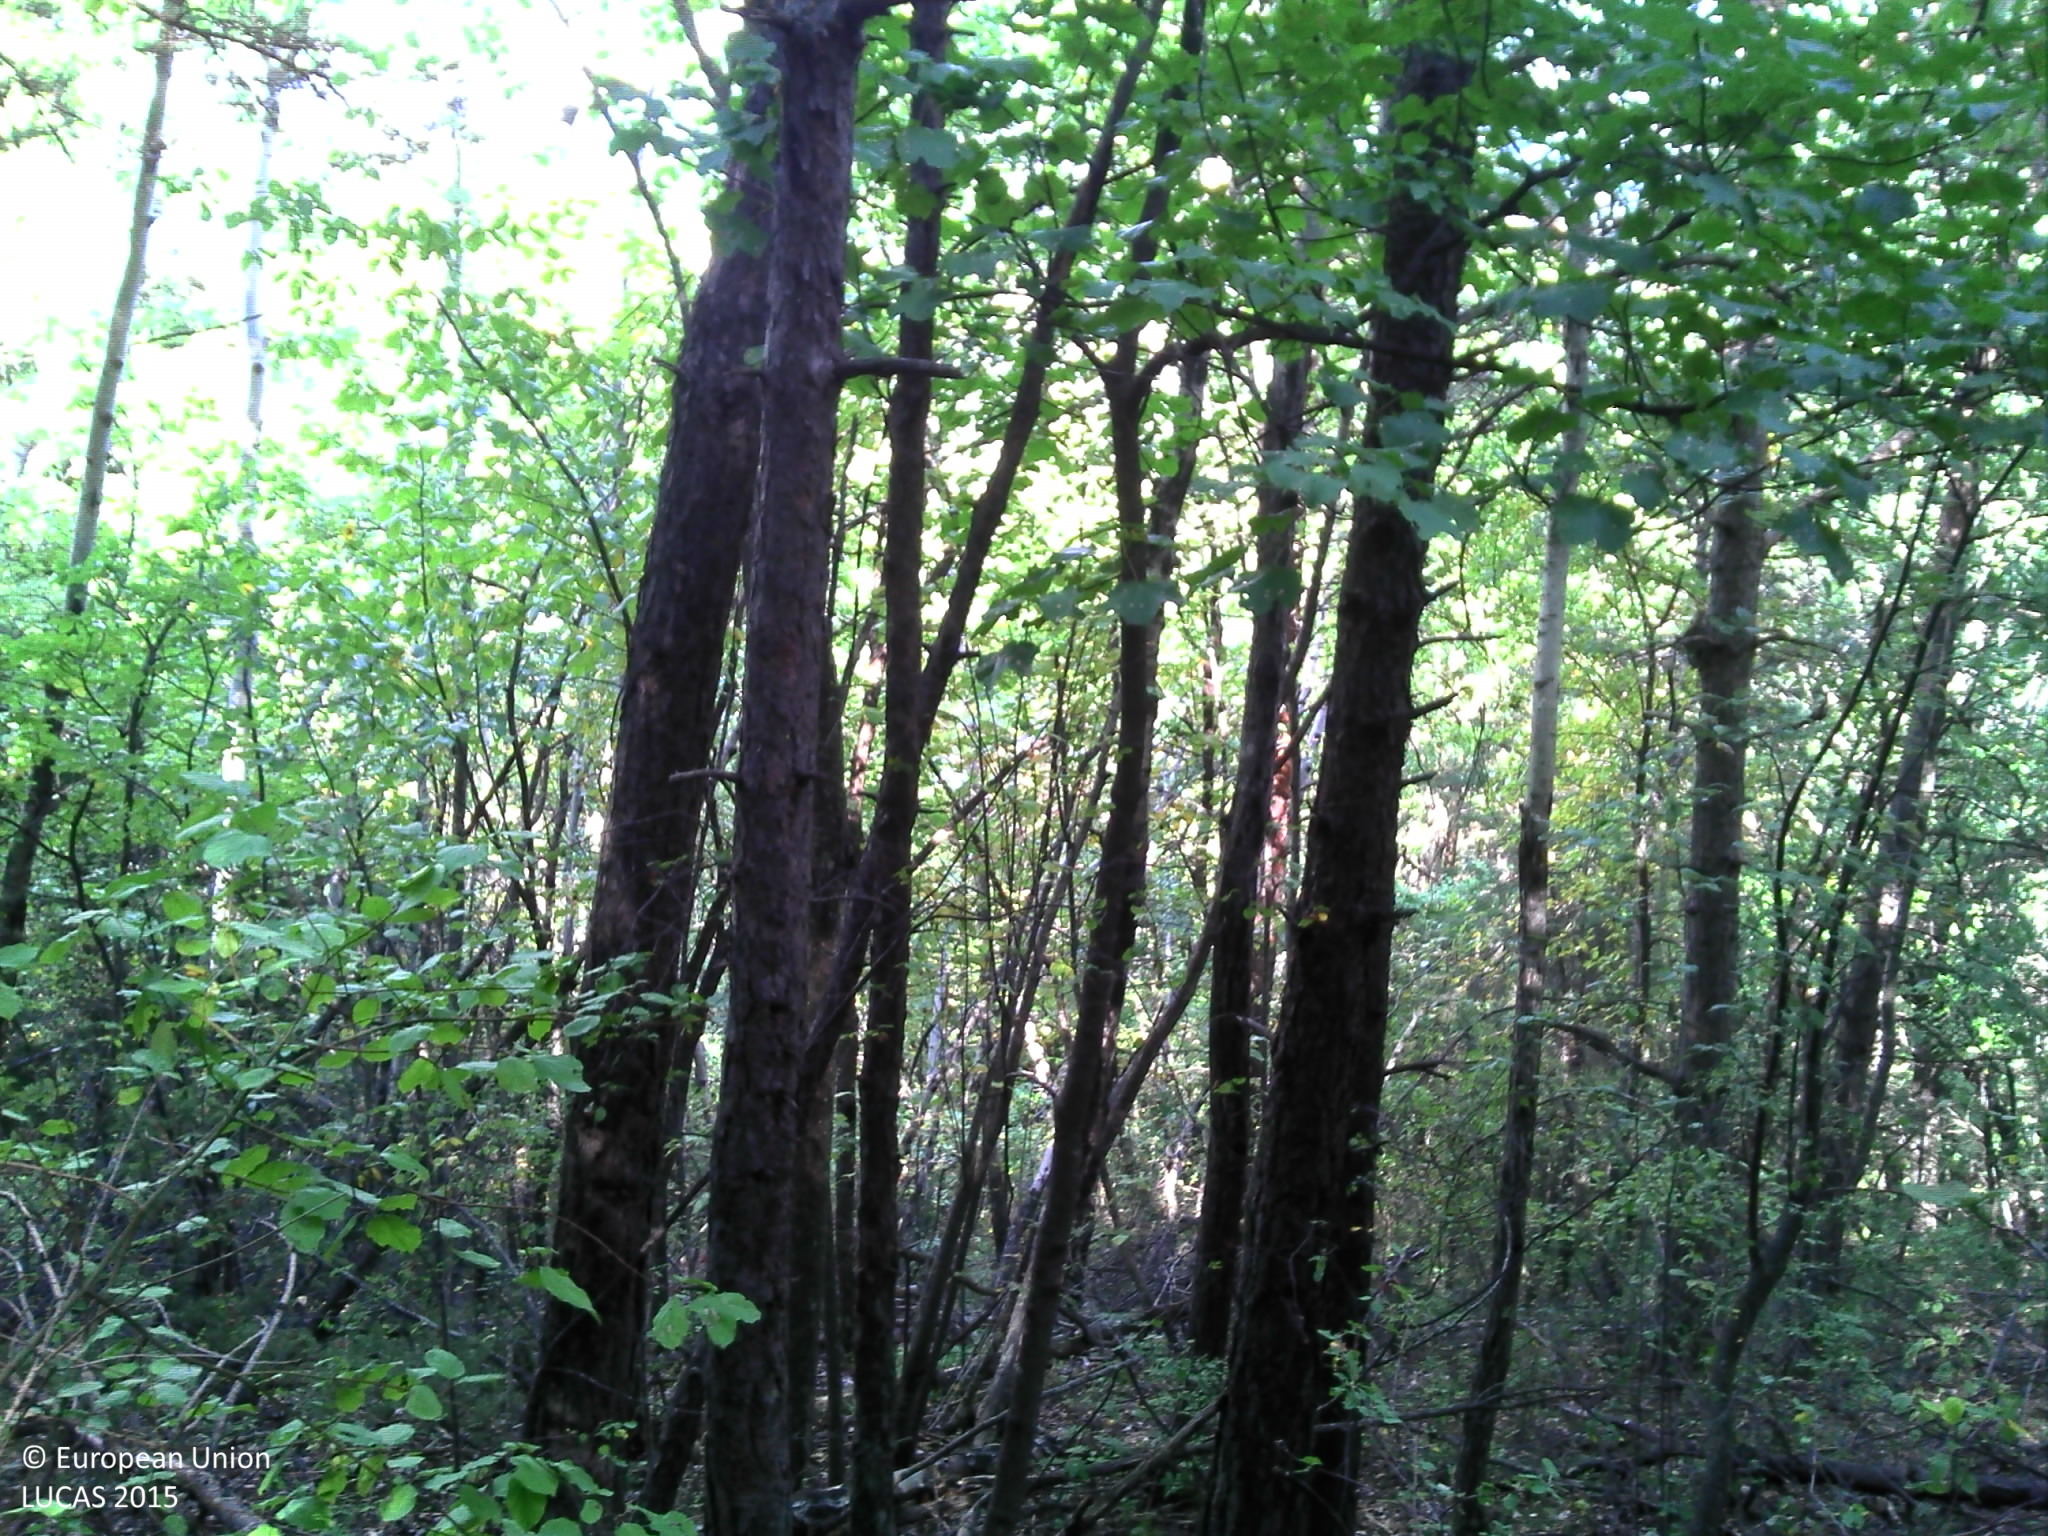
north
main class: Woodland
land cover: Pine dominated mixed woodland
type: hemiboreal forest and nemoral coniferous forest and mixed broadleaved-coniferous forest
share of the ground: > 75 %
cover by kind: coniferous forest trees 60 %, broadleaved forest trees 30 %, herbaceous plants 5 %, unconsolidated bare surface 5 %
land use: Forestry
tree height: > 5 m
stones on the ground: < 10 %
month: September
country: FR
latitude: 44.5235
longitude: 6.4205
